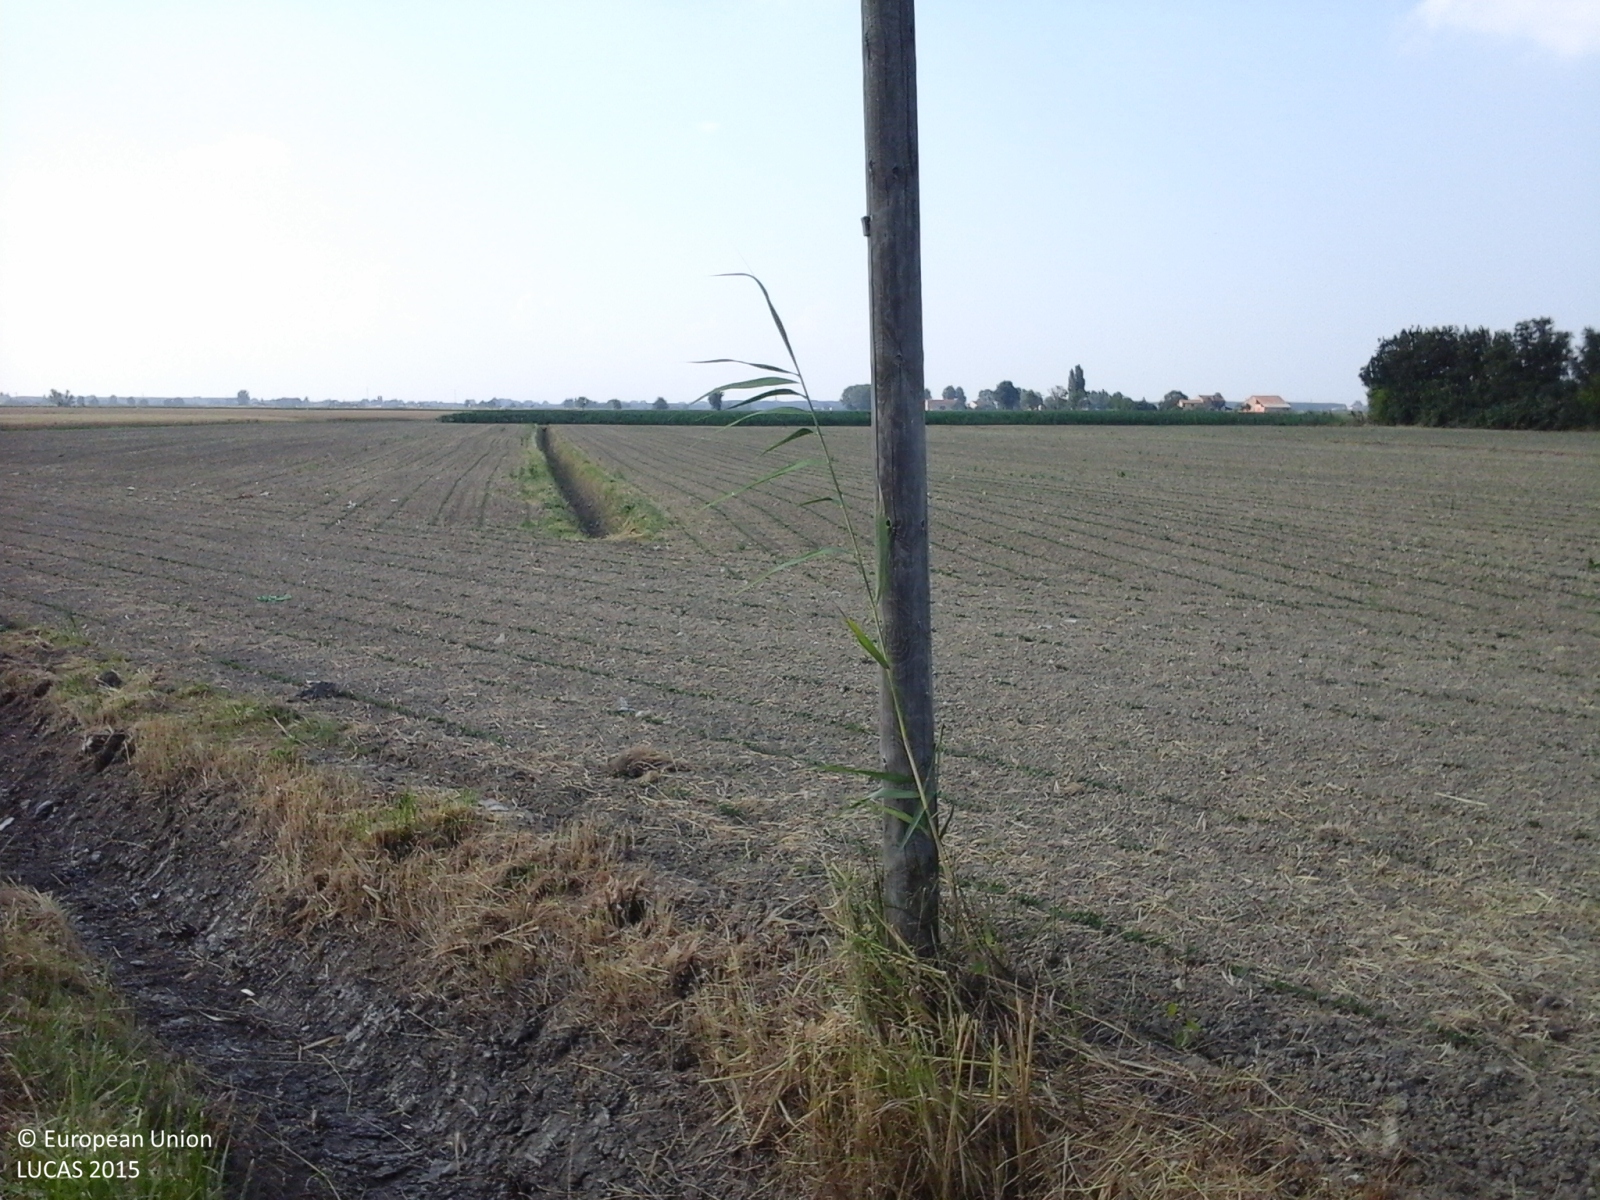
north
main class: Cropland
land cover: Soya
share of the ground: < 10 %
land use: Agriculture (excluding fallow land and kitchen gardens)
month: June
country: IT
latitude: 44.9124
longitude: 11.7826
